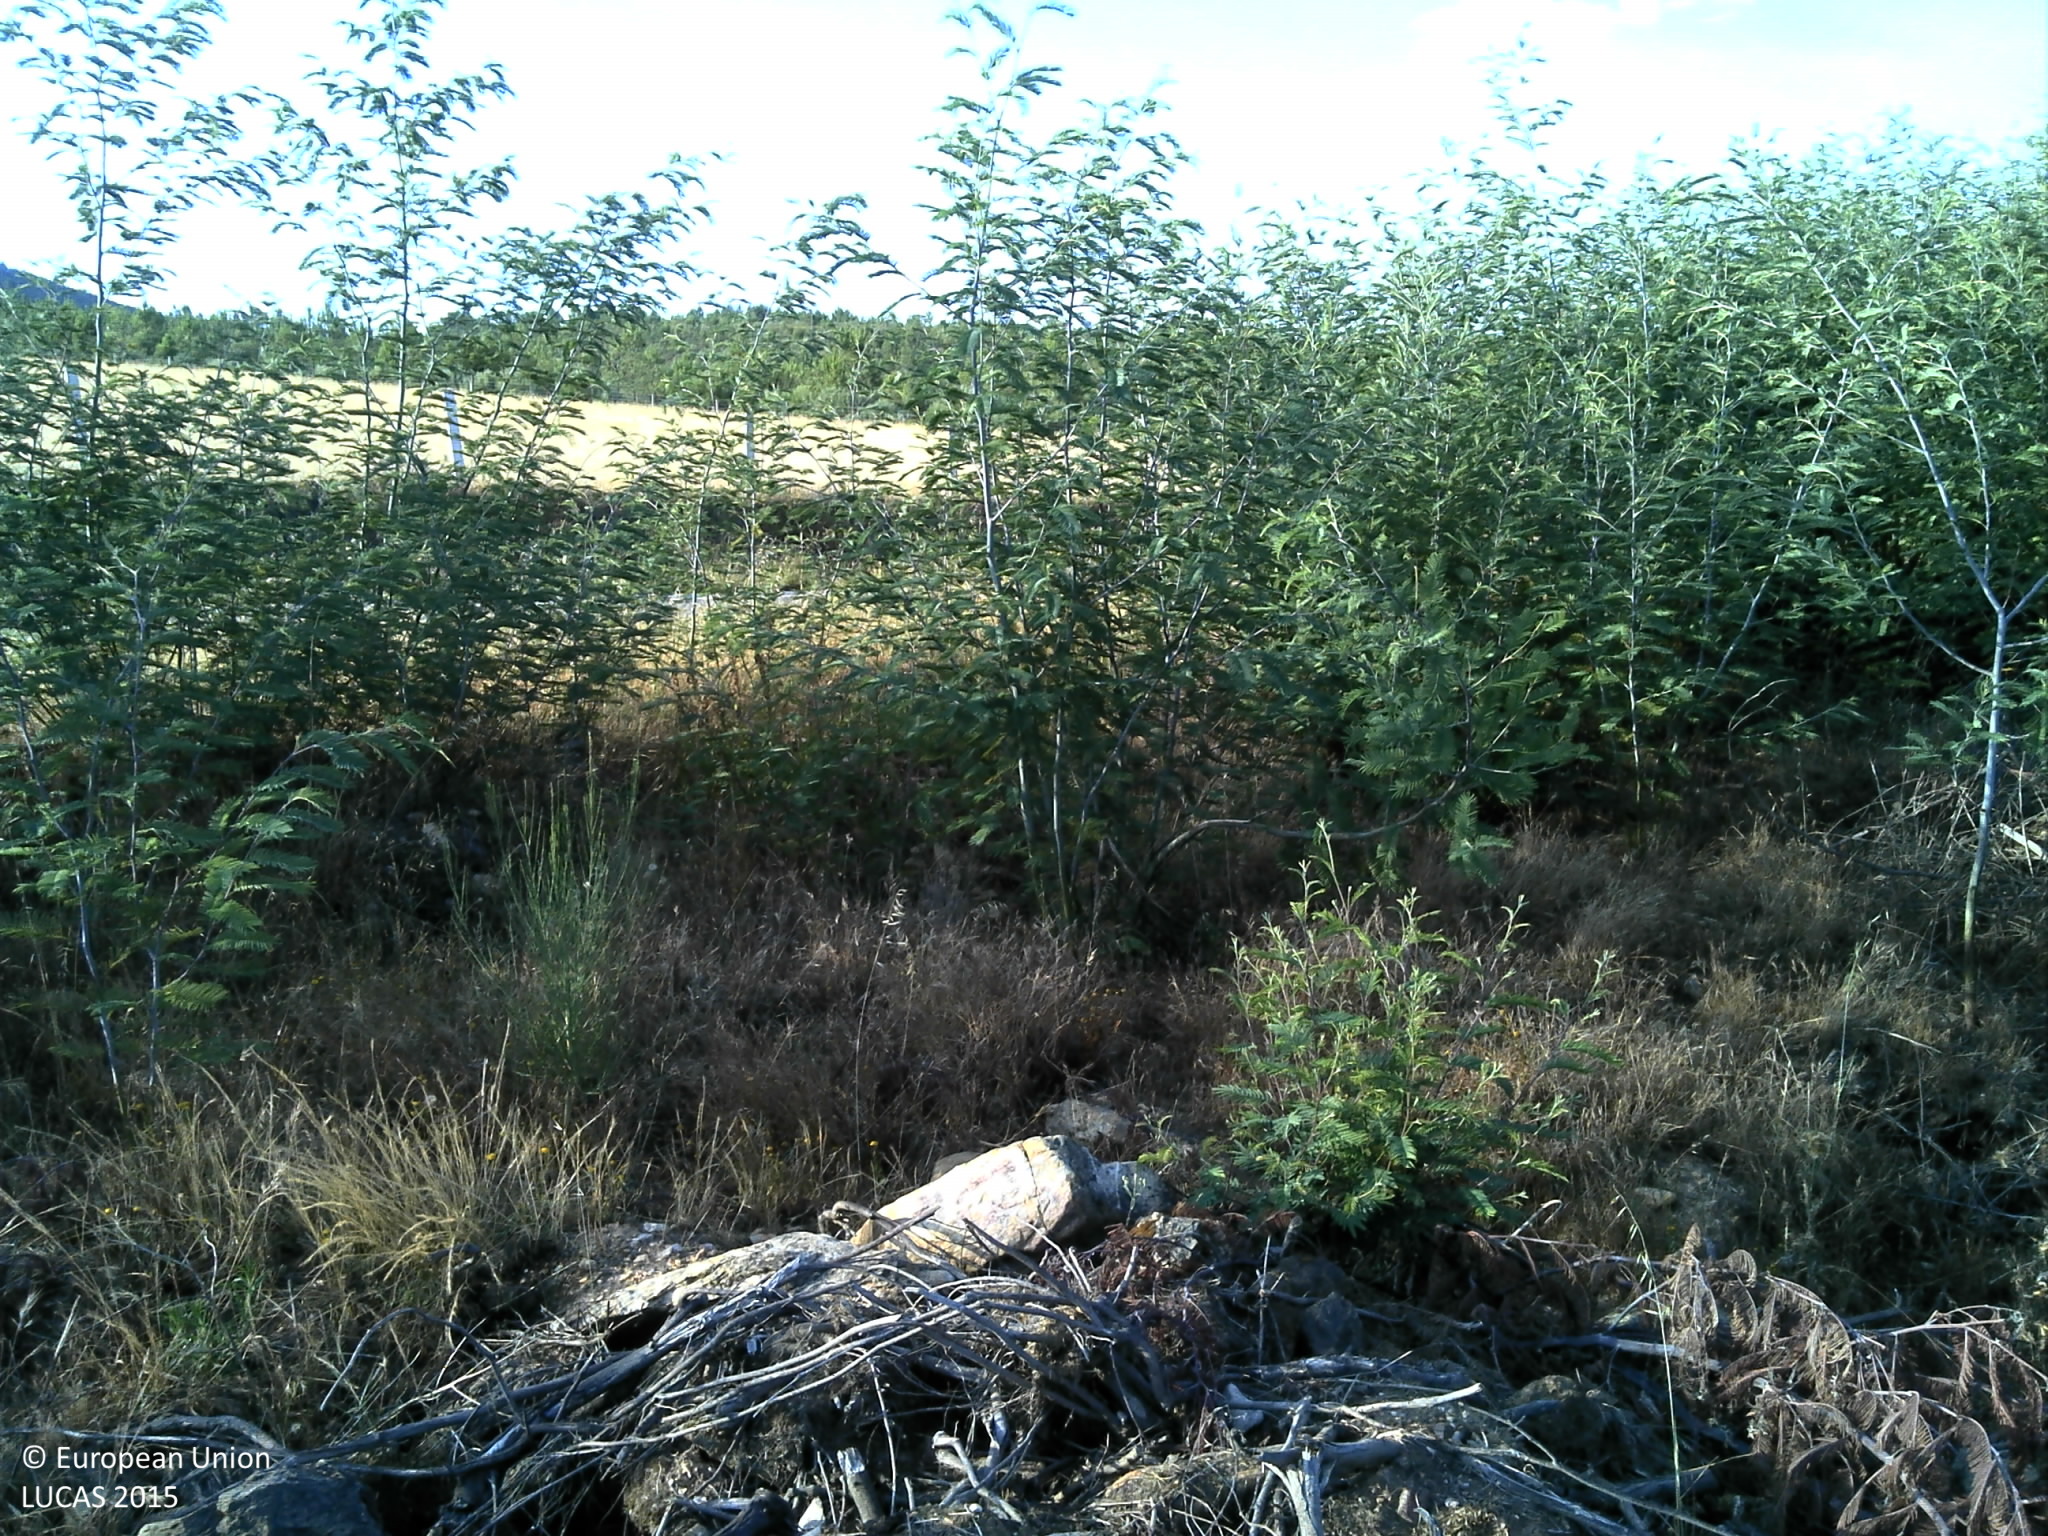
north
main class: Woodland
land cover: Broadleaved woodland
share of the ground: 10 - 25 %
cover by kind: unconsolidated bare surface 65 %, broadleaved forest trees 15 %, herbaceous plants 10 %, consolidated bare surface 10 %
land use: Semi-natural and natural areas not in use
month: June
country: PT
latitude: 41.4514
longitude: -7.2744
